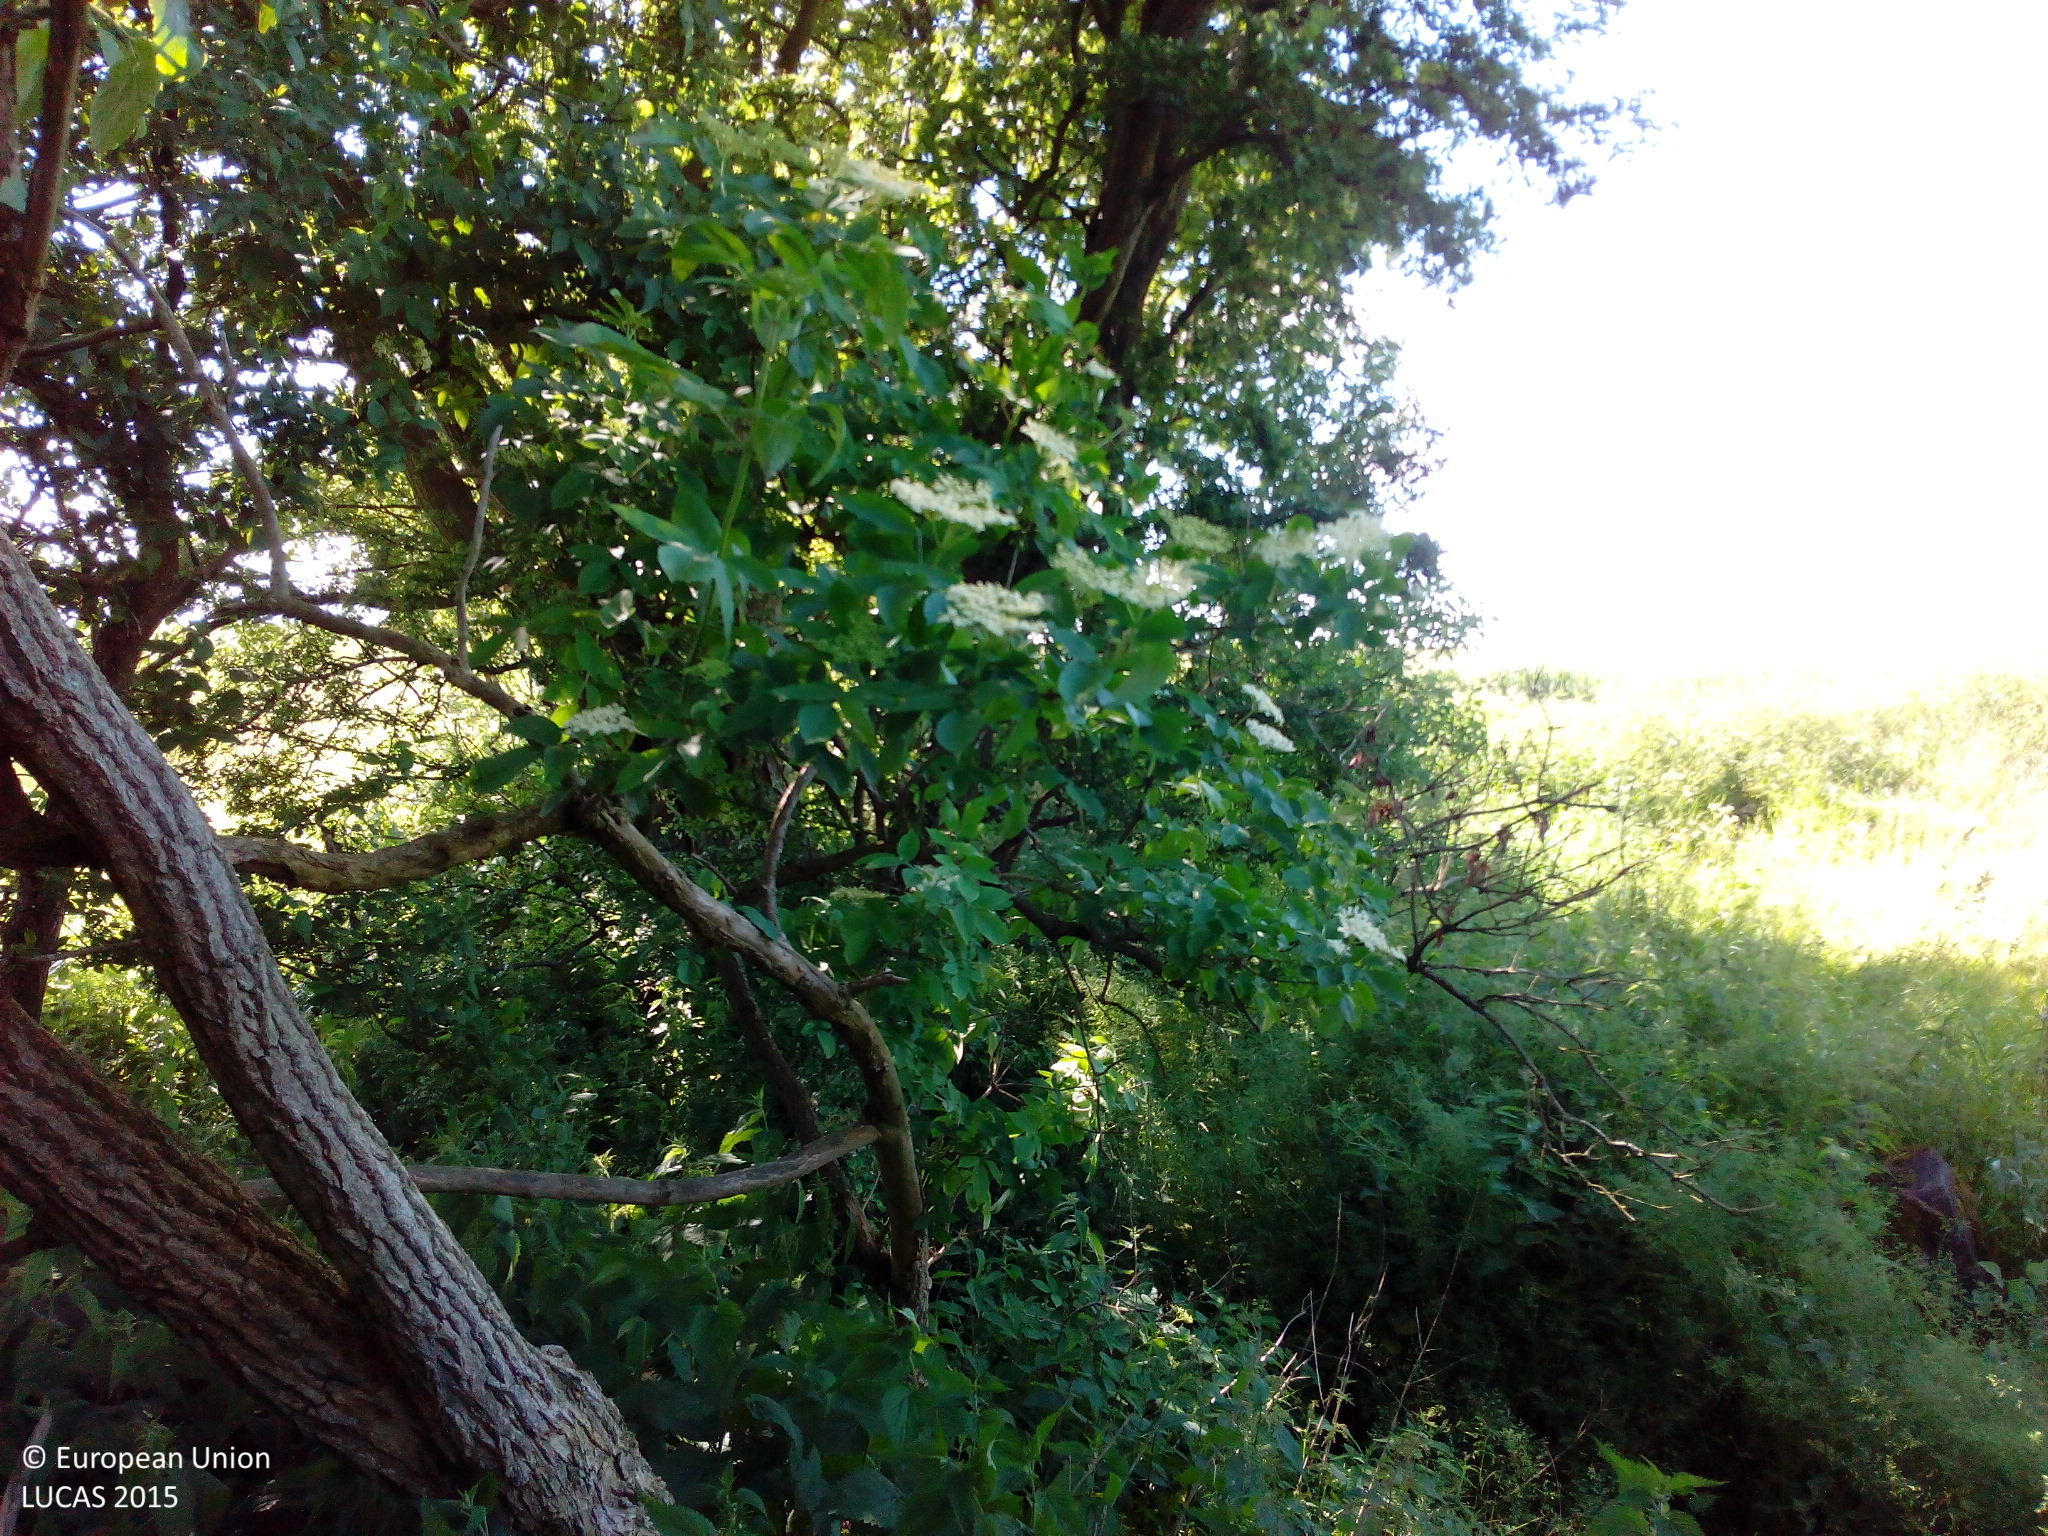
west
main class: Woodland
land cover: Broadleaved woodland
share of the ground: 50 - 75 %
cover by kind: broadleaved forest trees 55 %, herbaceous plants 35 %, shrubs 10 %
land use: Semi-natural and natural areas not in use
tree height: > 5 m
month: June
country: DK
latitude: 56.3113
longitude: 10.7588
